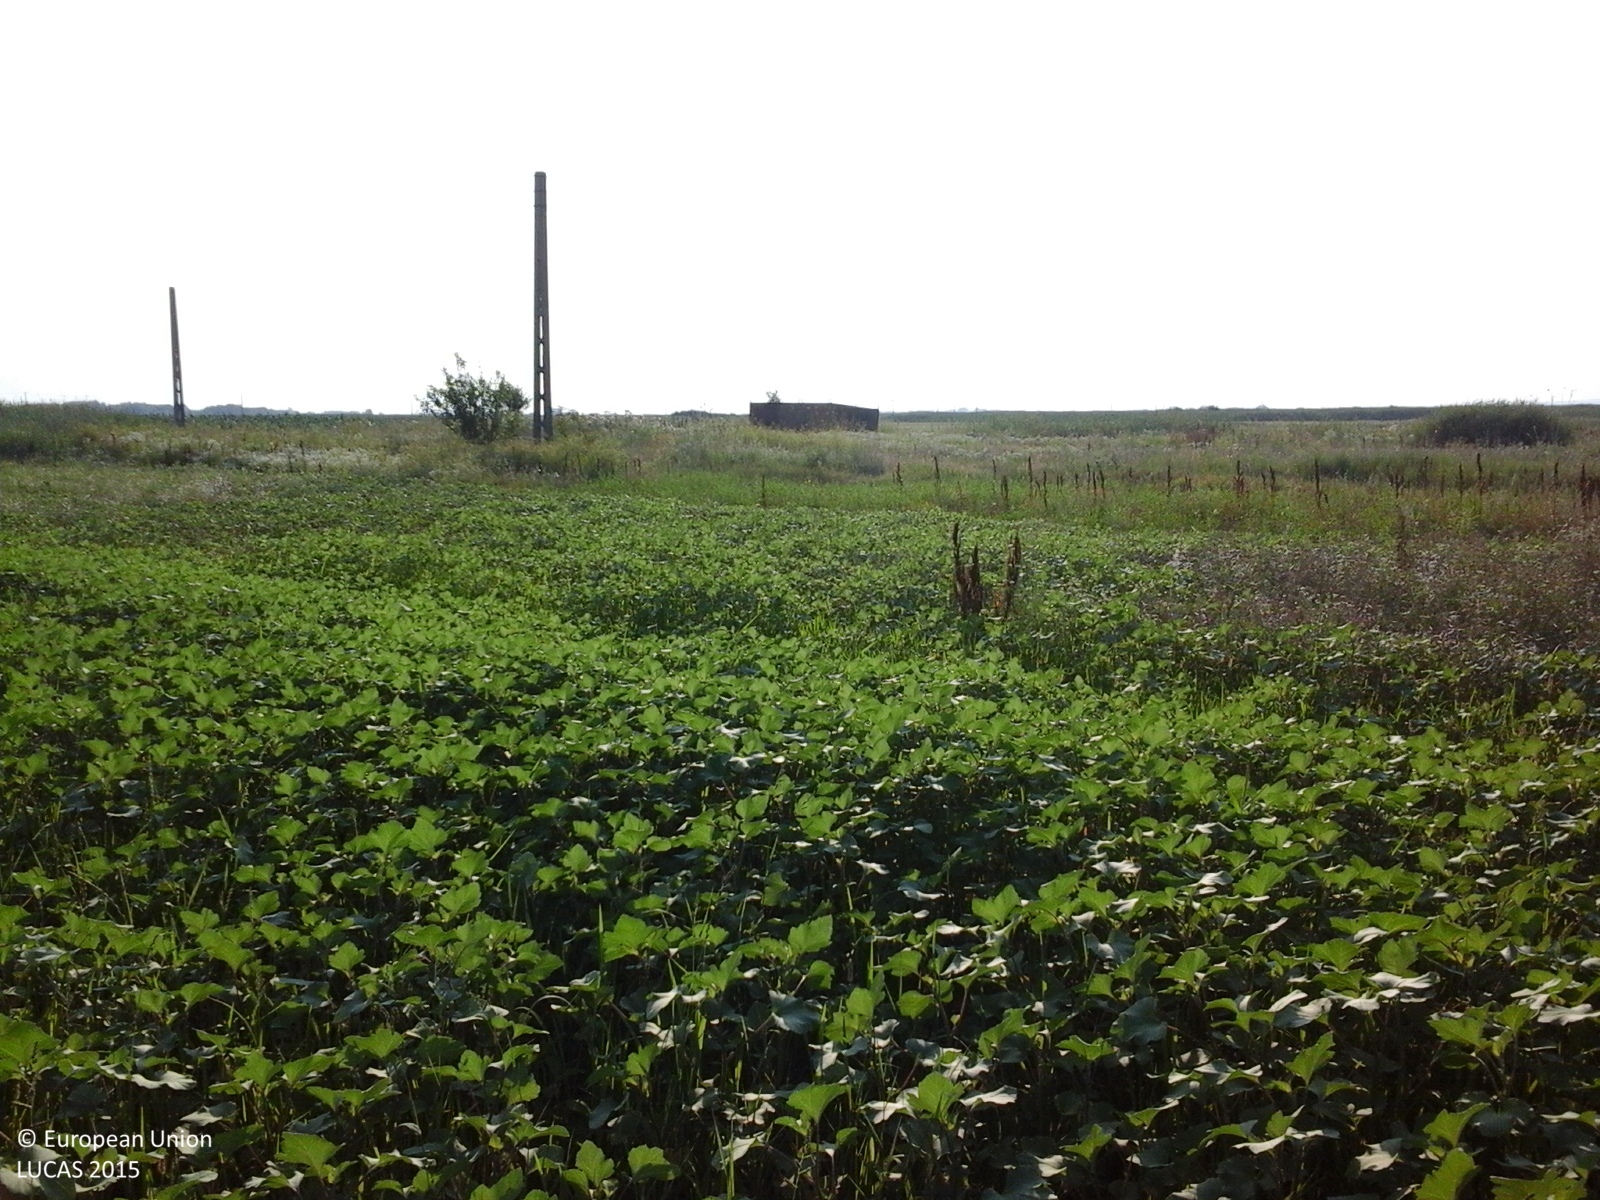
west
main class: Grassland
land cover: Spontaneously vegetated surfaces
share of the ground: > 75 %
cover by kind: herbaceous plants 100 %
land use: Fallow land
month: July
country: RO
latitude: 44.8812
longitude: 25.6319
